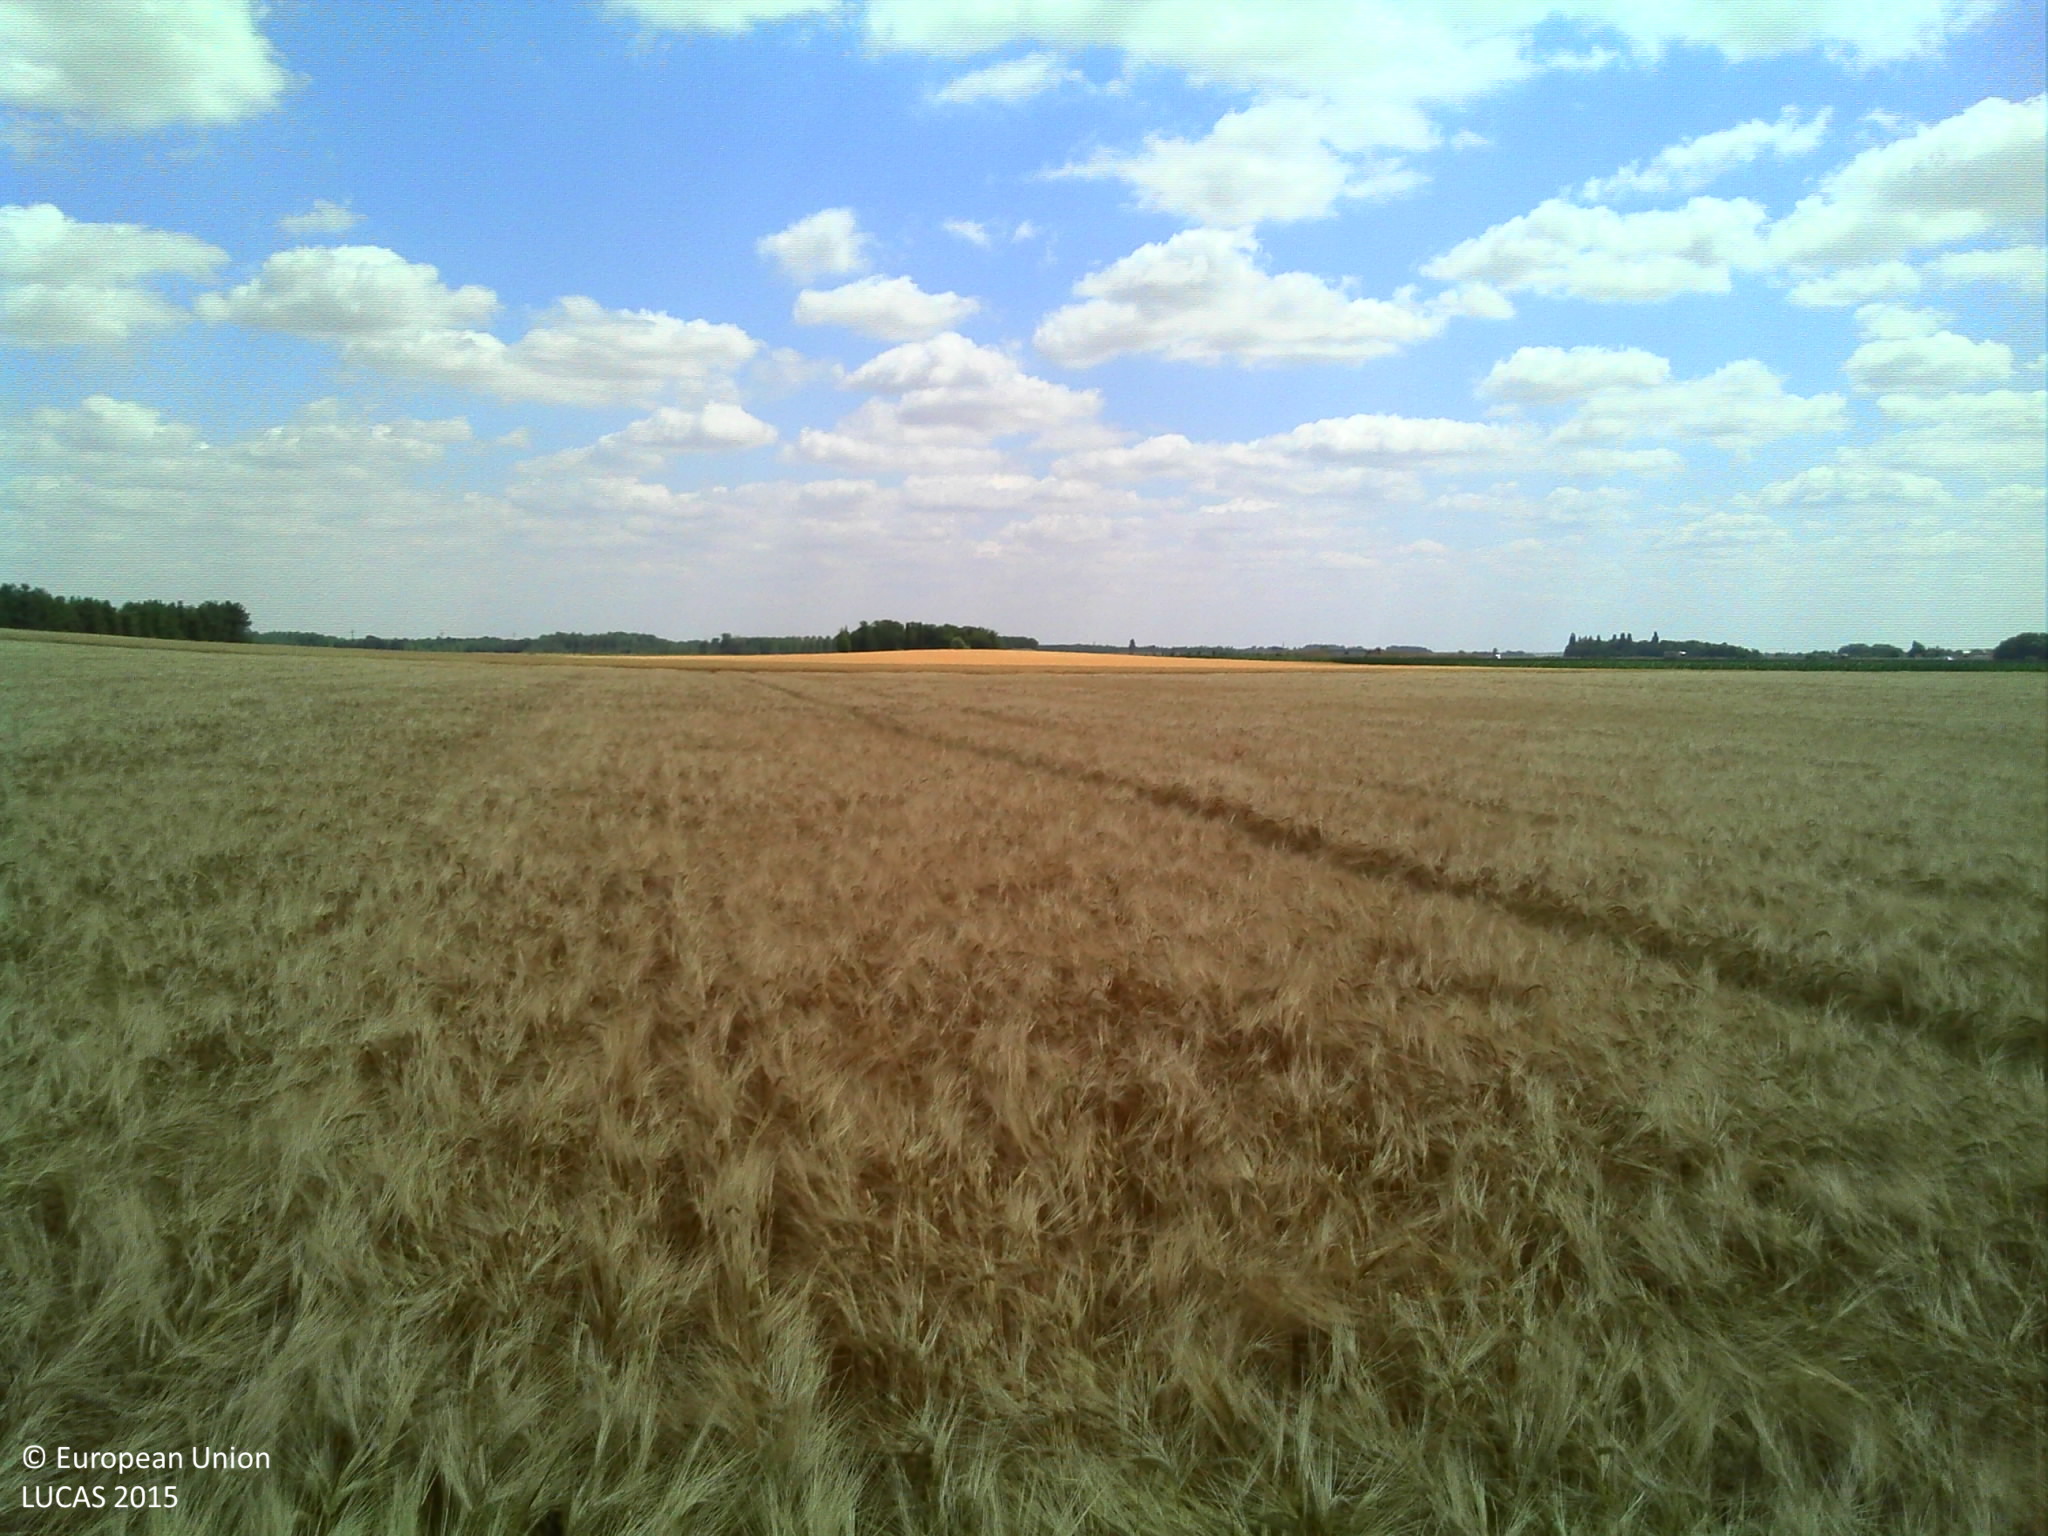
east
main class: Cropland
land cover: Barley
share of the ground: > 75 %
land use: Agriculture (excluding fallow land and kitchen gardens)
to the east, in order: Barley; Tracks; Durum wheat
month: July
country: FR
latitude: 48.0970
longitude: 2.5381
